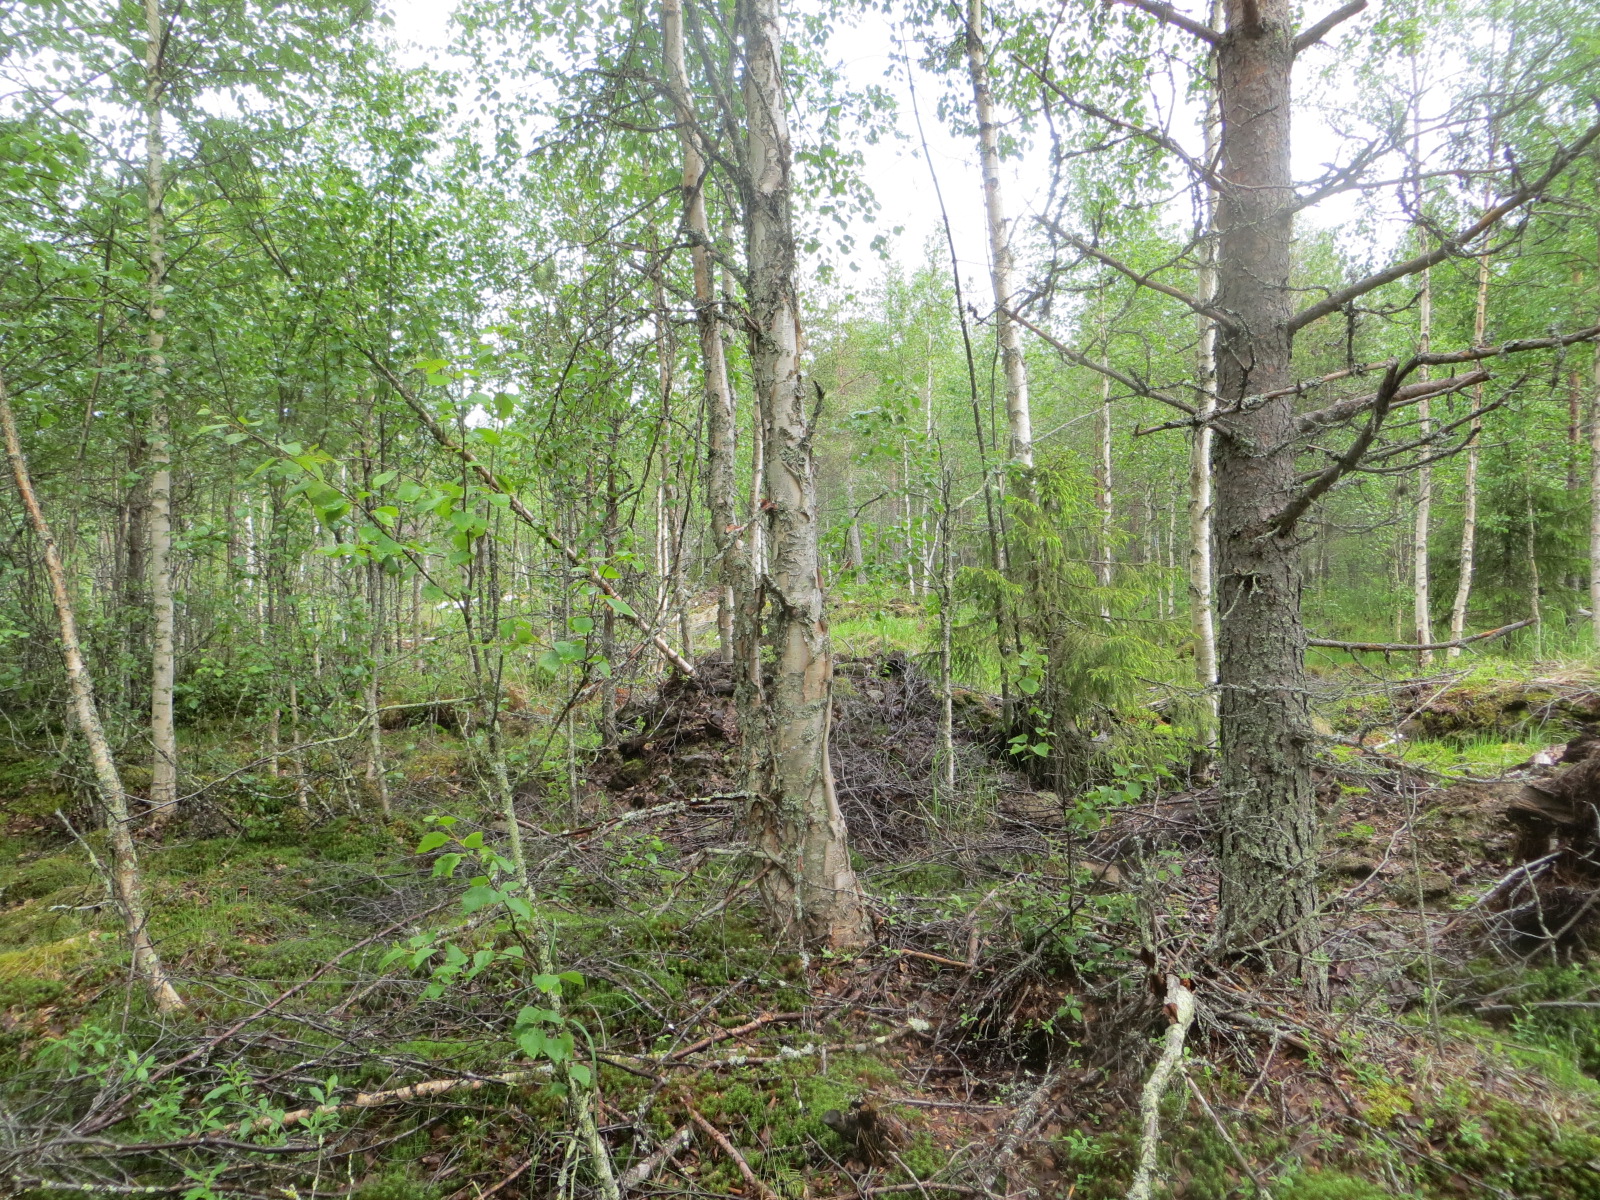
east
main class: Woodland
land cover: Broadleaved woodland
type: boreal forest
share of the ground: > 75 %
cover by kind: broadleaved forest trees 80 %, lichens and mosses 10 %, shrubs 5 %, herbaceous plants 5 %
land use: Forestry
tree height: > 5 m
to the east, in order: Broadleaved woodland; Ditches and canals; Pine dominated mixed woodland; Ditches and canals; Pine dominated mixed woodland; Ditches and canals; Pine dominated mixed woodland; Pine dominated coniferous woodland; Ditches and canals; Pine dominated coniferous woodland; Paved roads, cycling and walking lanes; Ditches and canals; Pine dominated mixed woodland
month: June
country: FI
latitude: 66.0990
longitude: 26.9370
